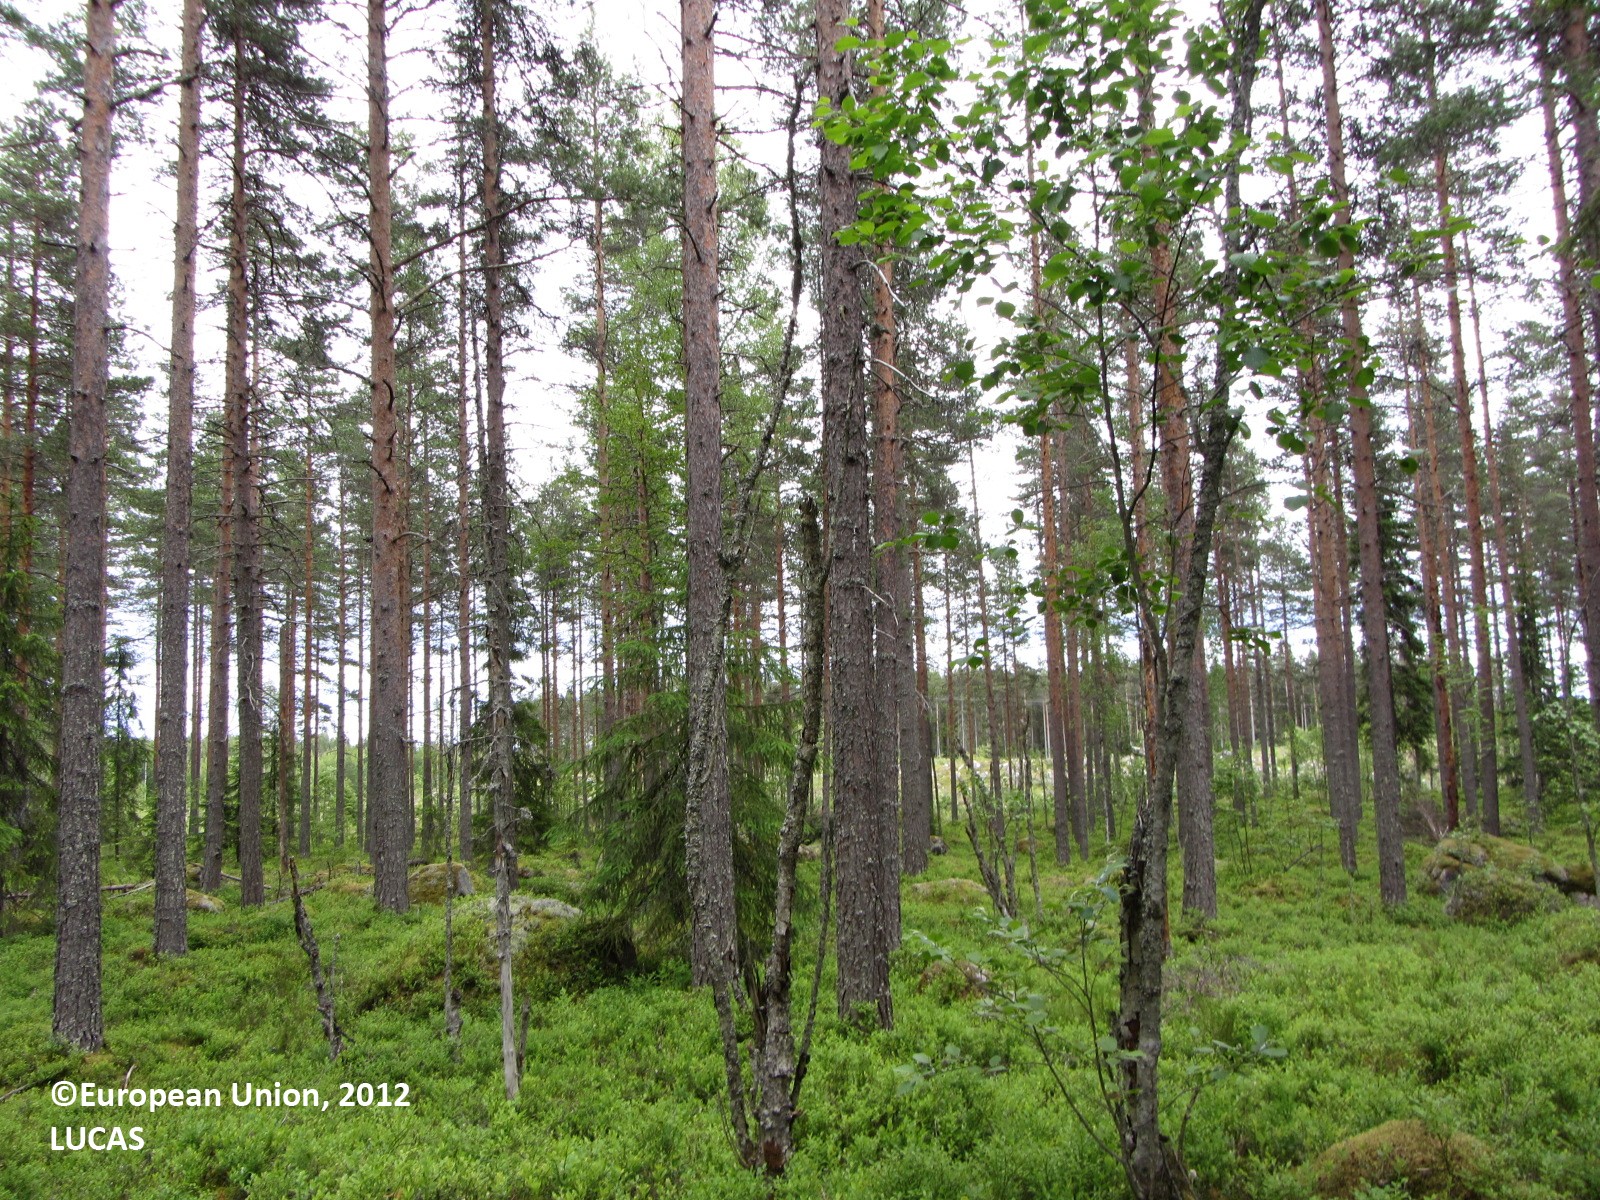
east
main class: Woodland
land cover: Pine dominated coniferous woodland
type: boreal forest
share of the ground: 50 - 75 %
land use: Forestry
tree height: > 5 m
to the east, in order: Pine dominated coniferous woodland; Pine dominated mixed woodland; Rock outcrops; Pine dominated mixed woodland; Rock outcrops; Electric lines; Managed hedges; Ditches and canals; Paved roads, cycling and walking lanes; Ditches and canals; Spruce dominated mixed woodland; Shrubland with sparse tree cover; Grassland with sparse tree/shrub cover
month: June
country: FI
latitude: 62.7516
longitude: 25.5974
